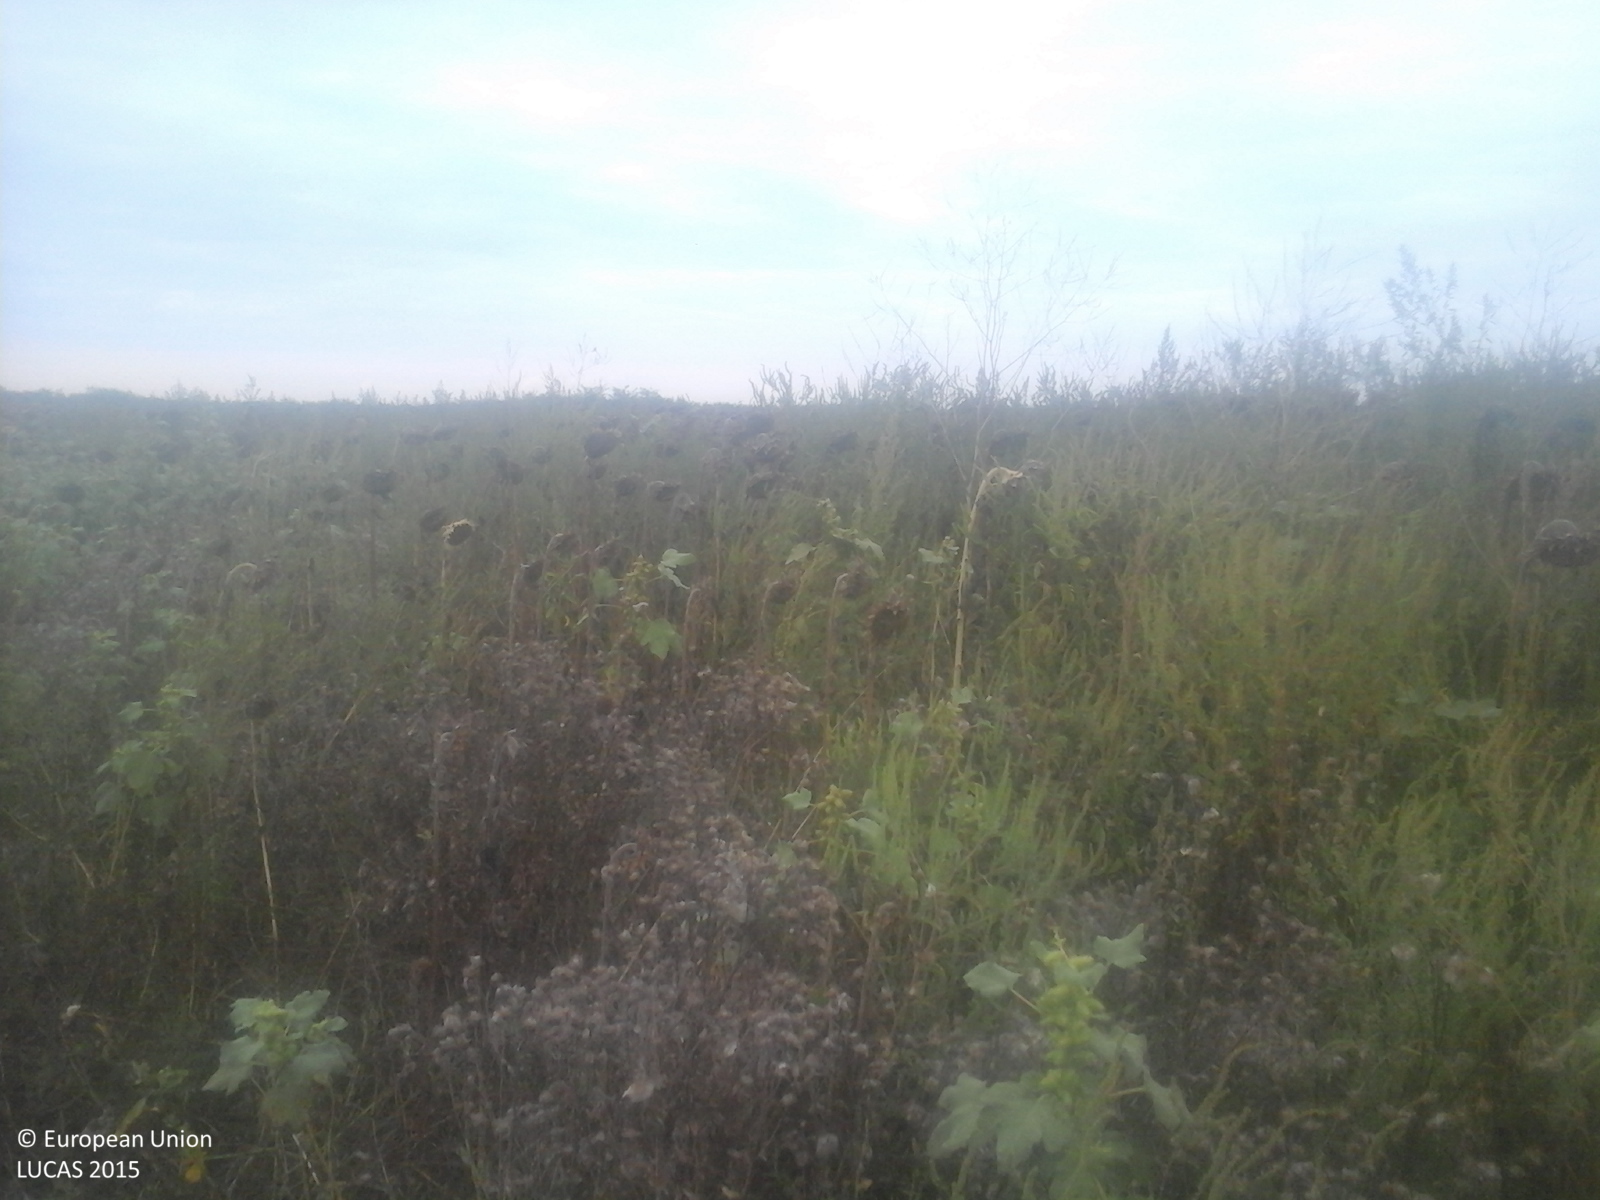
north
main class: Cropland
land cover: Sunflower
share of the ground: > 75 %
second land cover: Spontaneously vegetated surfaces
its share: > 75 %
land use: Agriculture (excluding fallow land and kitchen gardens)
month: September
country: RO
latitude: 47.7415
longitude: 22.6908
